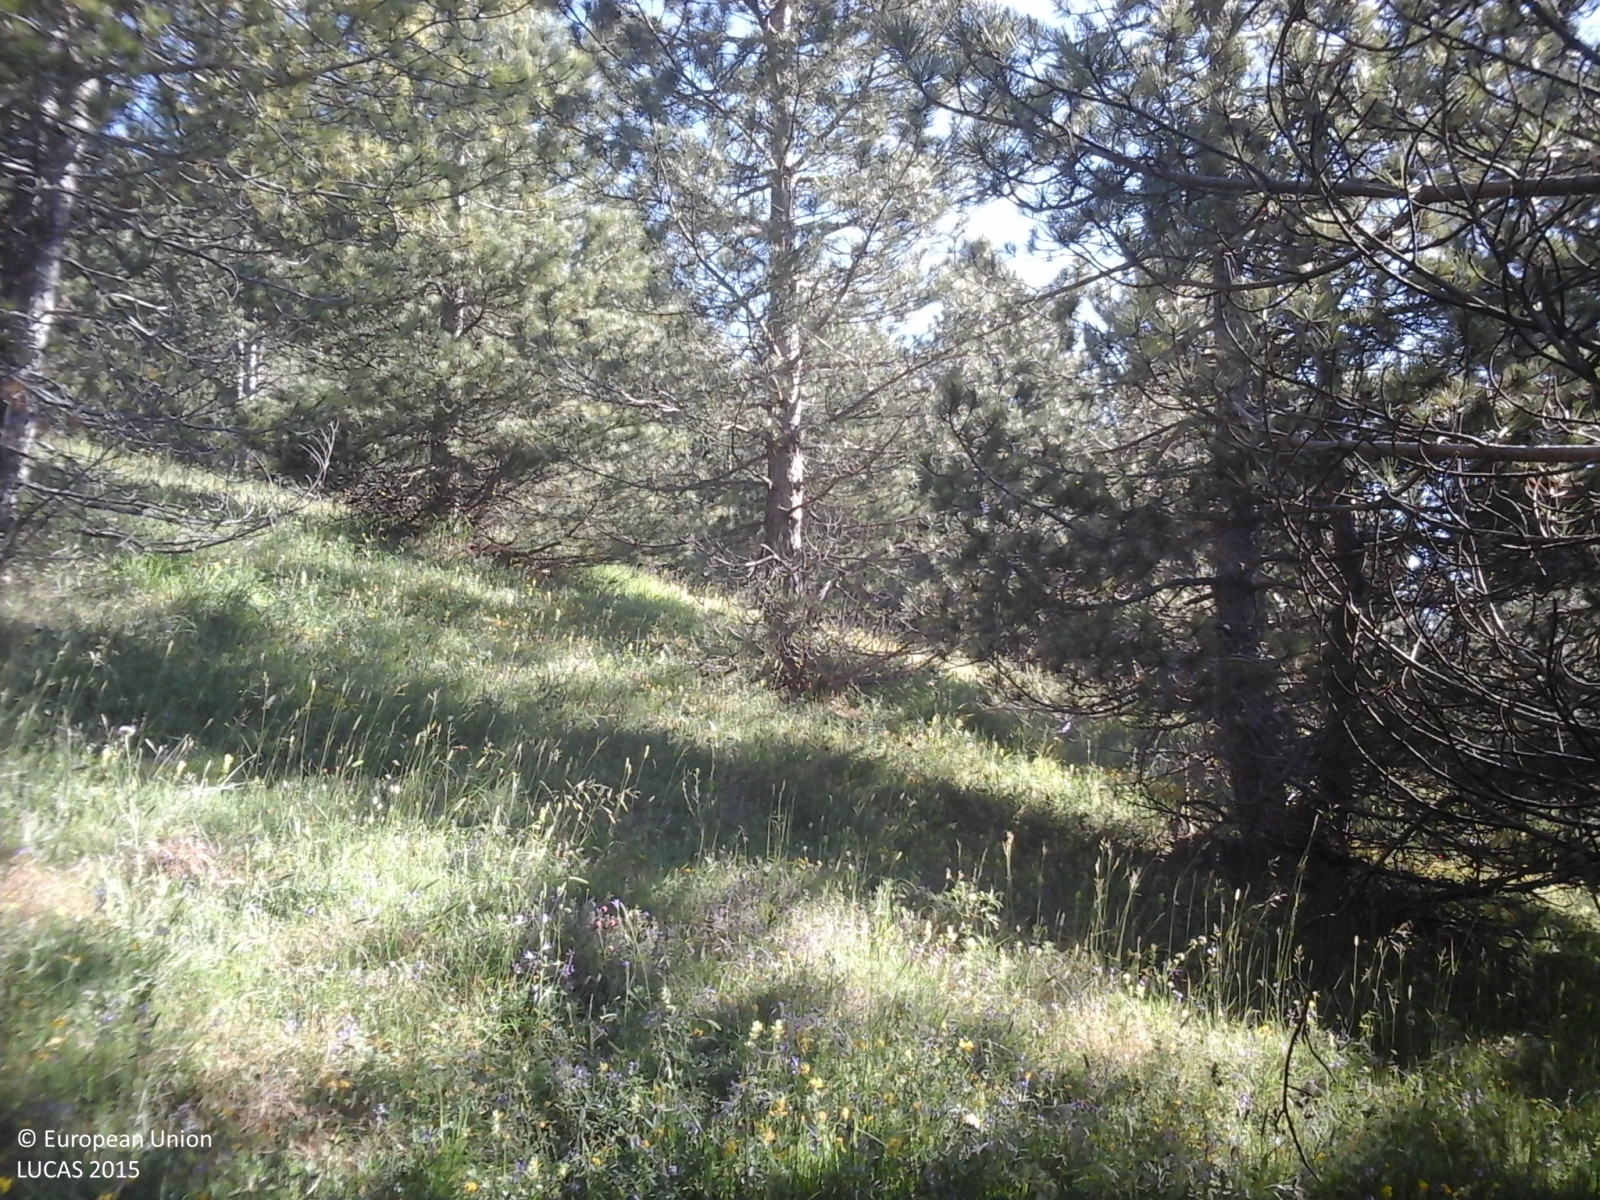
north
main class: Woodland
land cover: Other coniferous woodland
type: coniferous forest of the mediterranean region
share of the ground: > 75 %
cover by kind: coniferous forest trees 95 %, herbaceous plants 5 %
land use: Forestry
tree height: > 5 m
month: June
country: IT
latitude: 42.7480
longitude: 13.2035
